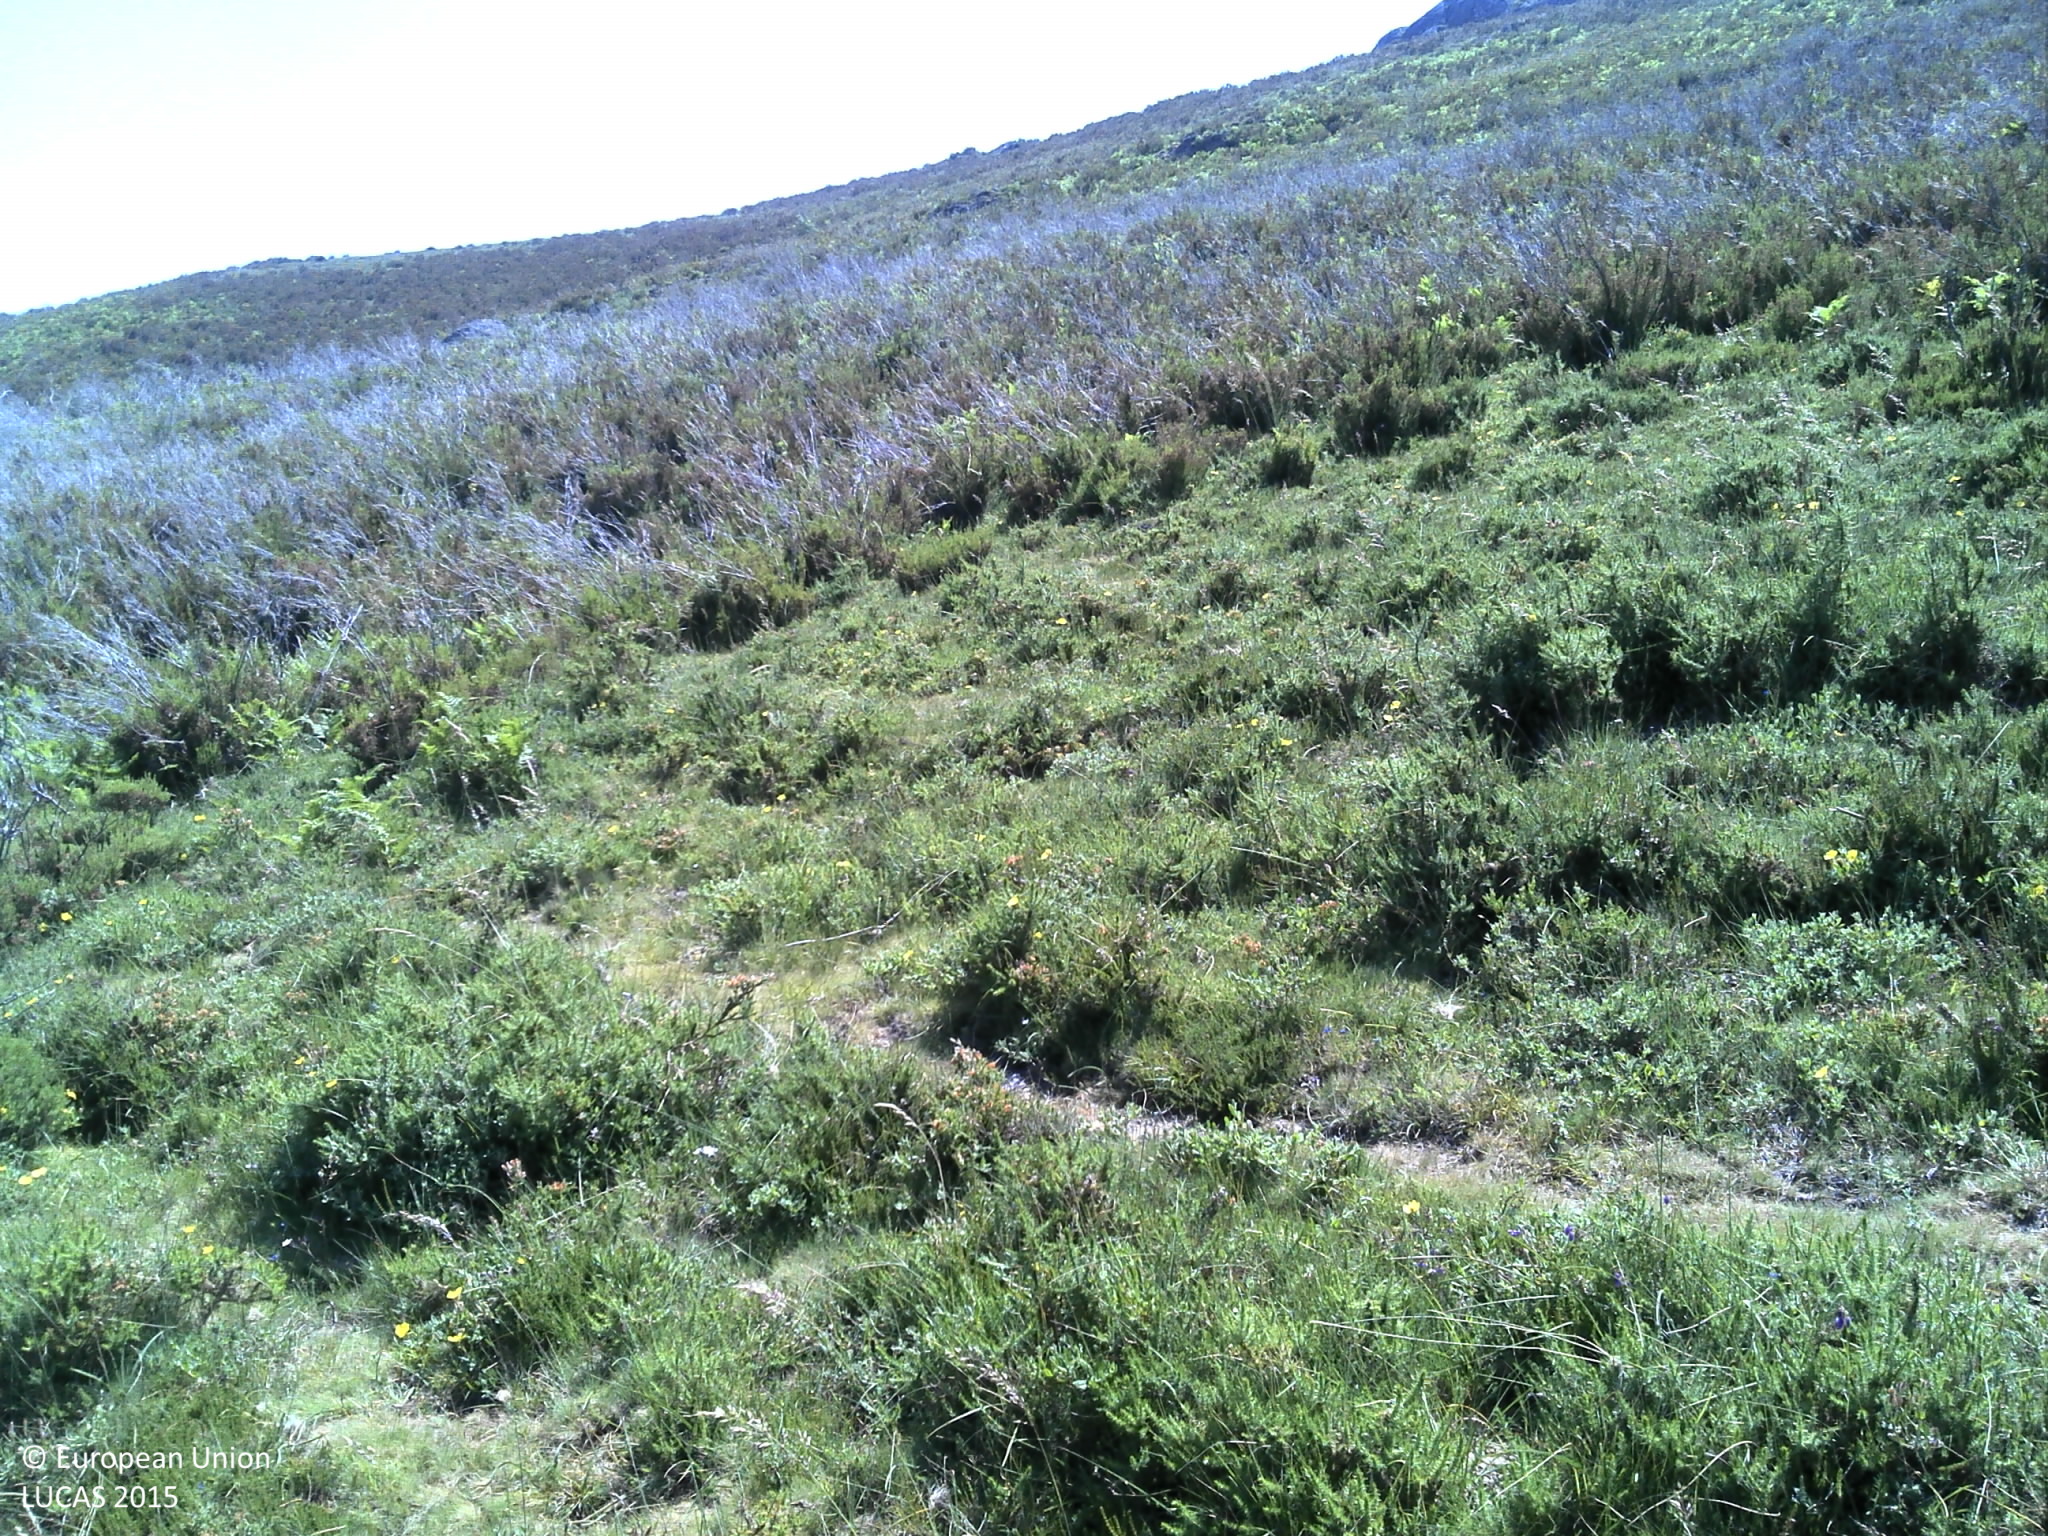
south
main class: Shrubland
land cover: Shrubland without tree cover
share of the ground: 25 - 50 %
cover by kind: shrubs 50 %, herbaceous plants 45 %, unconsolidated bare surface 5 %
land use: Agriculture (excluding fallow land and kitchen gardens)
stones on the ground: 10 - 25 %
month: June
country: PT
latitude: 41.9904
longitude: -8.2750
